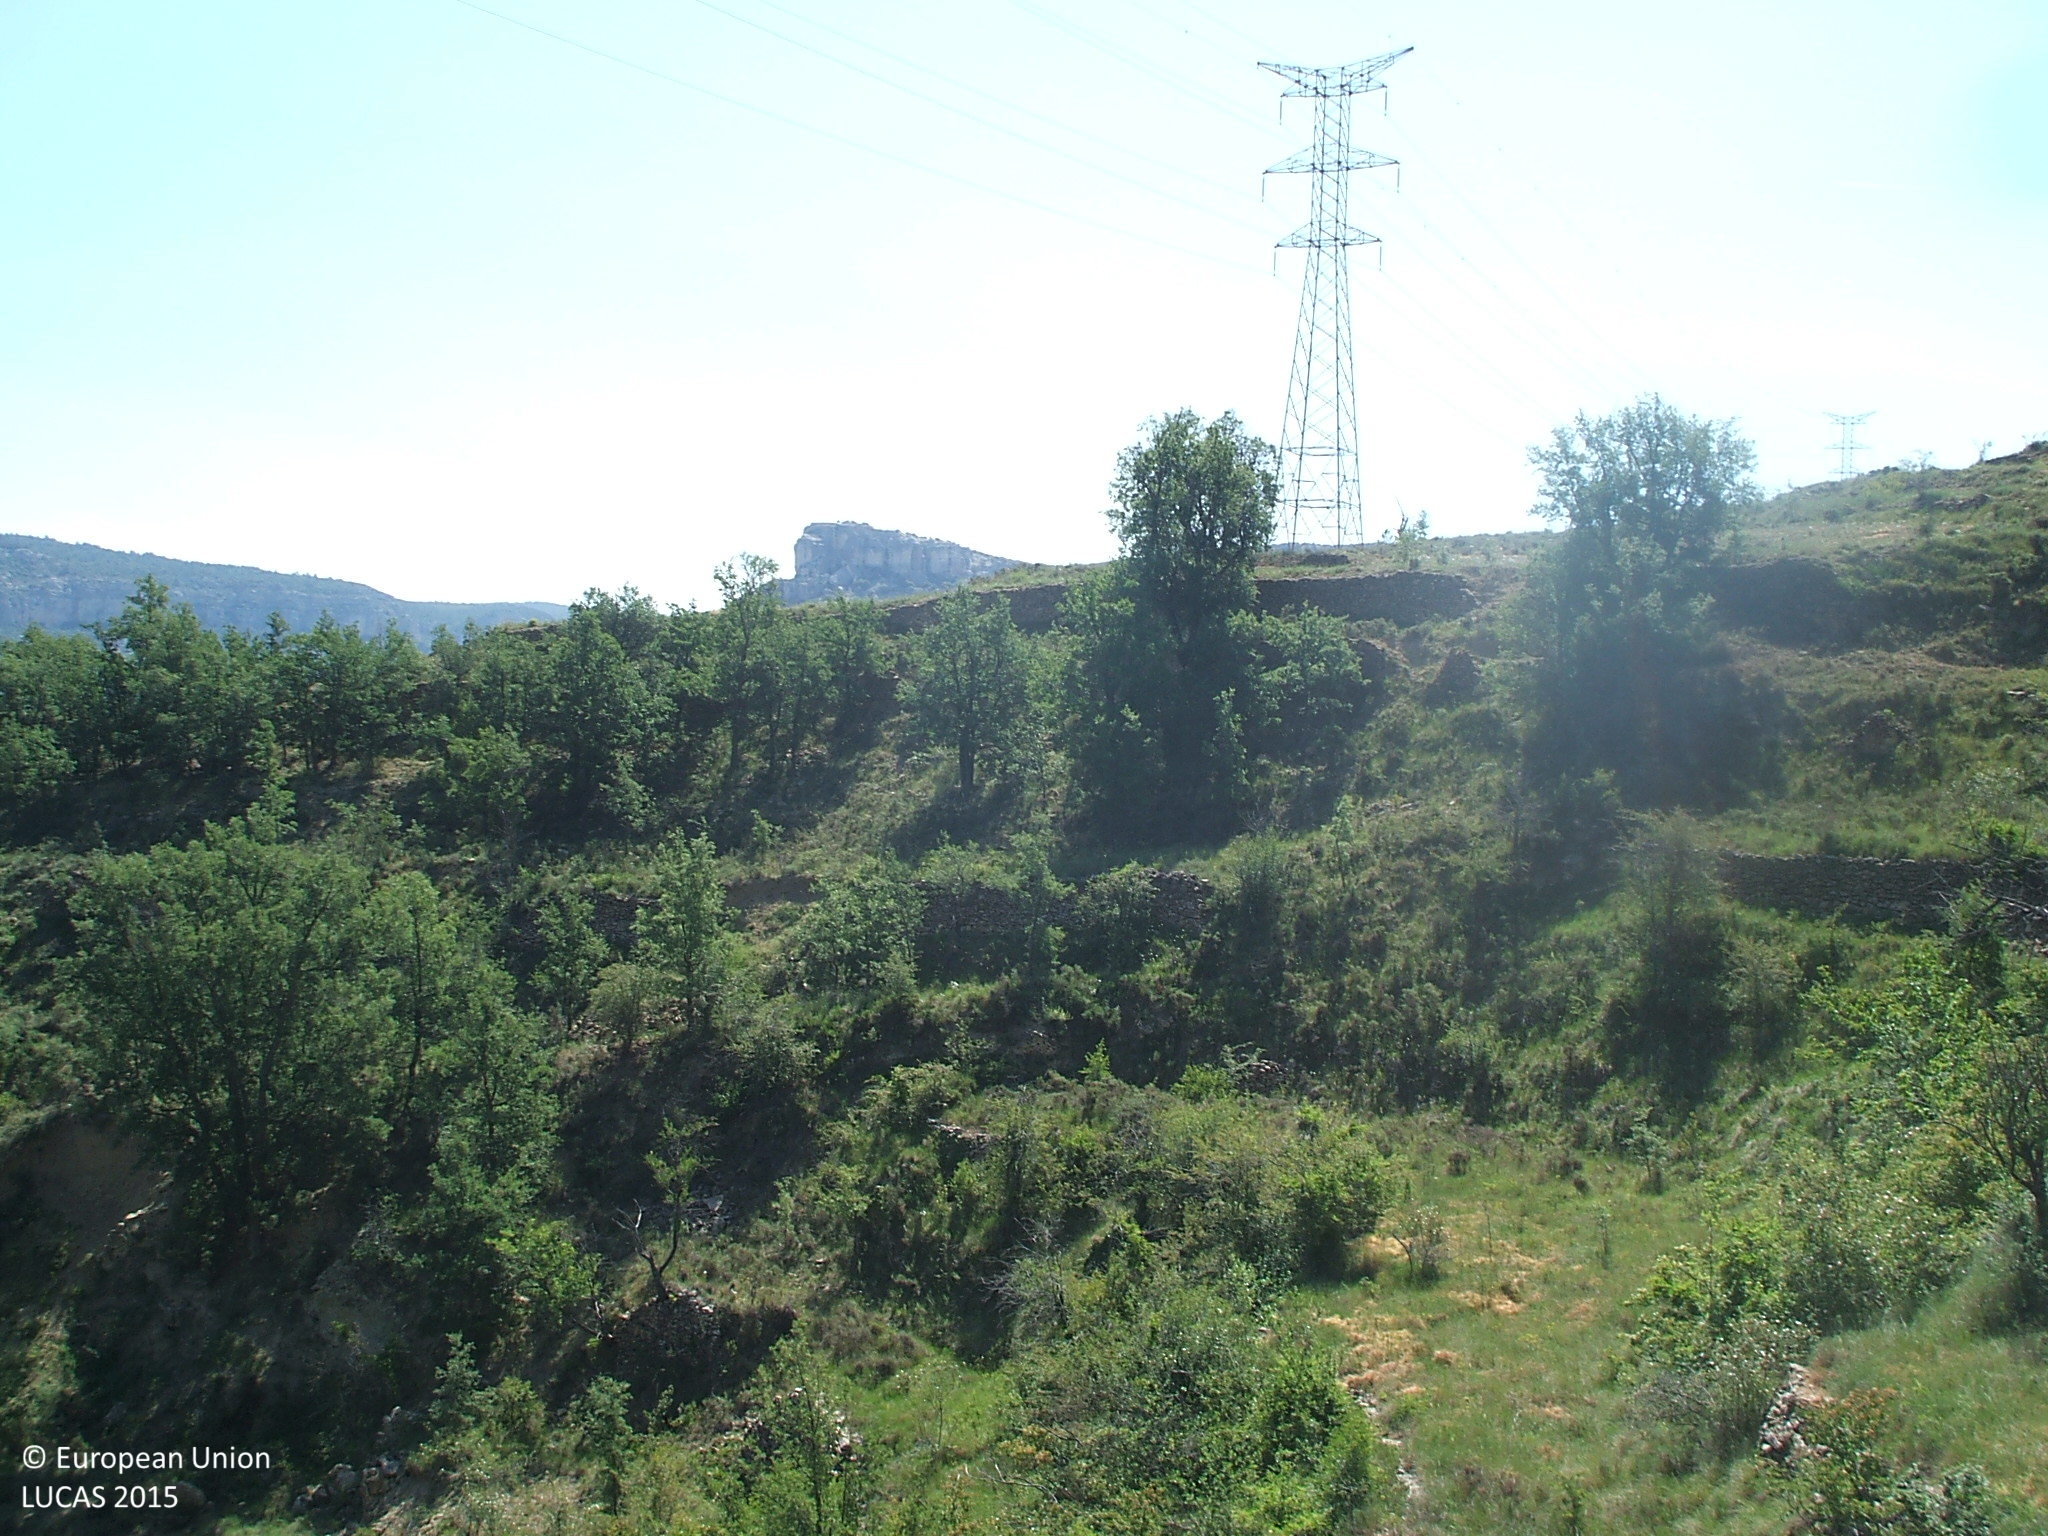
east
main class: Shrubland
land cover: Shrubland with sparse tree cover
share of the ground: > 75 %
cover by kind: shrubs 95 %, broadleaved forest trees 5 %
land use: Semi-natural and natural areas not in use
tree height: > 5 m
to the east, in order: Shrubland with sparse tree cover; Dry stone walls; Shrubland with sparse tree cover; Dry stone walls; Shrubland with sparse tree cover; Dry stone walls; Shrubland with sparse tree cover; Dry stone walls; Shrubland with sparse tree cover; Electric lines; Broadleaved woodland; Dry stone walls; Shrubland with sparse tree cover; Dry stone walls; Grassland with sparse tree/shrub cover; Dry stone walls; Shrubland with sparse tree cover; Dry stone walls; Shrubland with sparse tree cover; Dry stone walls; Shrubland with sparse tree cover; Dry stone walls; Shrubland with sparse tree cover; Tracks; Shrubland with sparse tree cover; Other bare soil
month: May
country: ES
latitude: 40.6439
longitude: -0.2132
